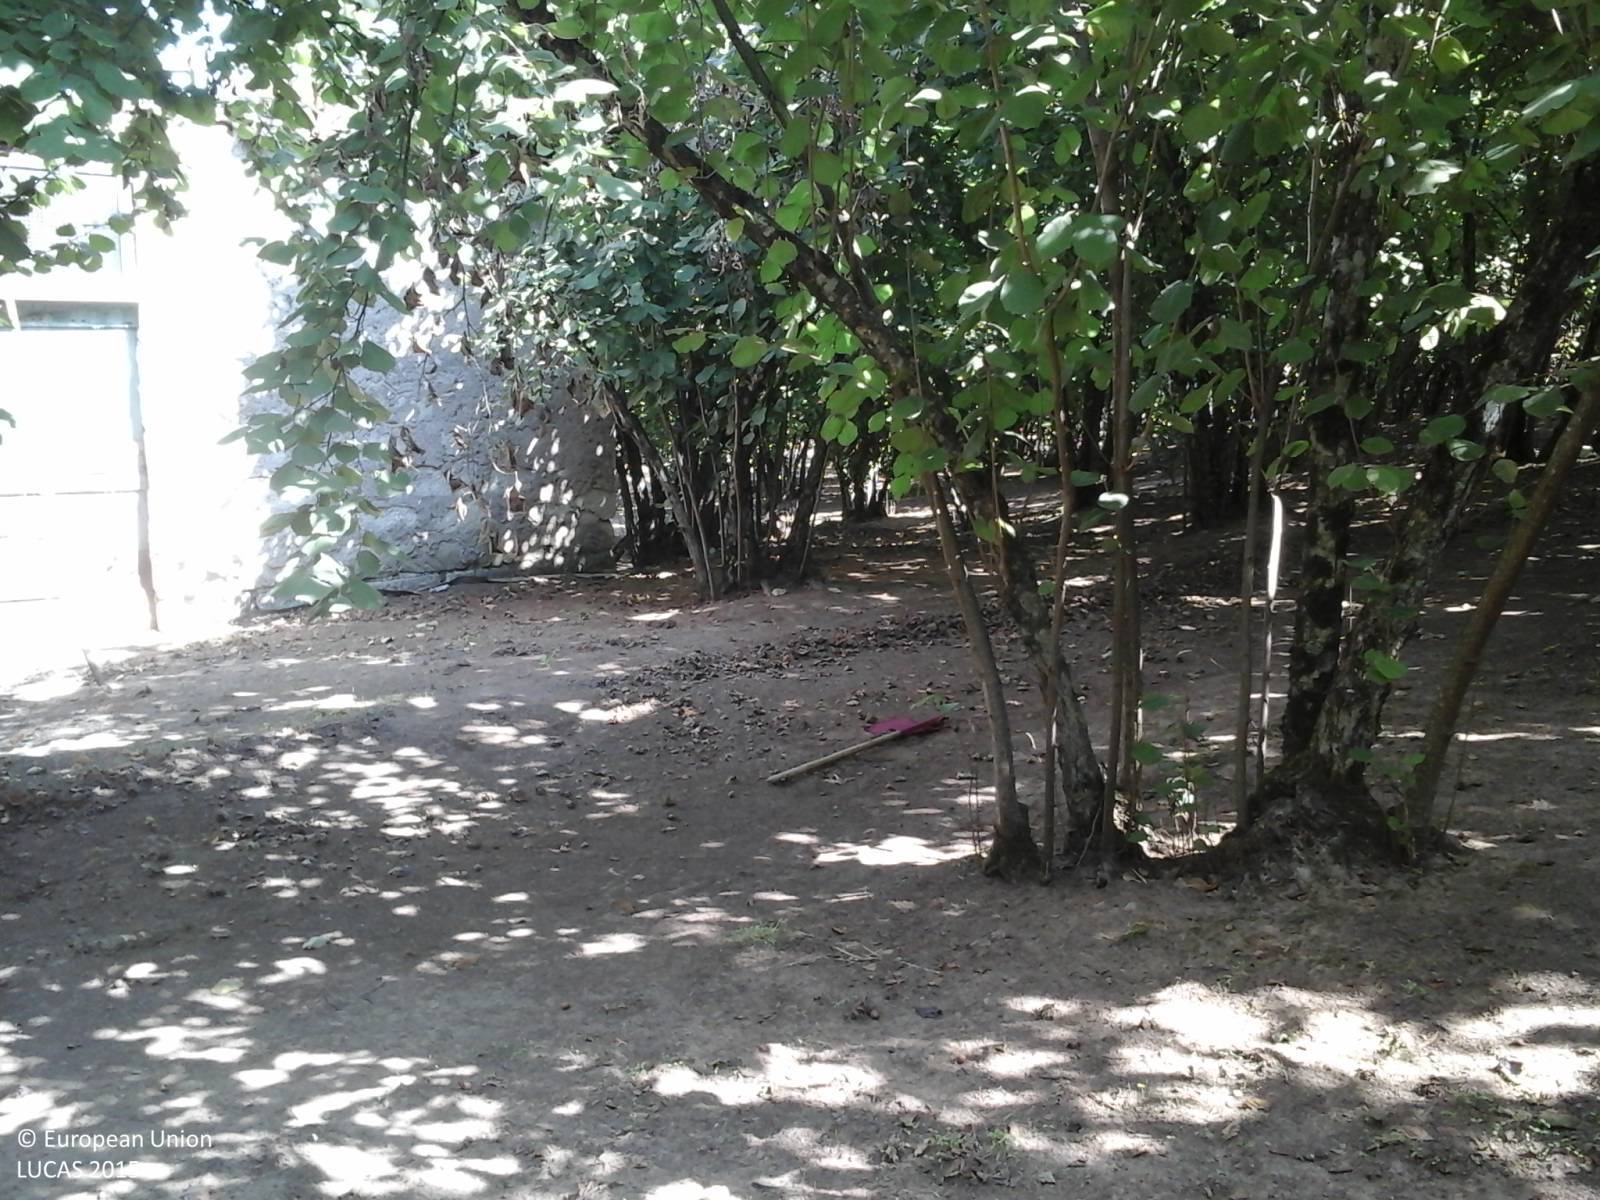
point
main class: Cropland
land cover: Nuts trees
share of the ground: > 75 %
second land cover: Other bare soil
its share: > 75 %
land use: Agriculture (excluding fallow land and kitchen gardens)
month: September
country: IT
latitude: 42.3211
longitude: 12.2854
